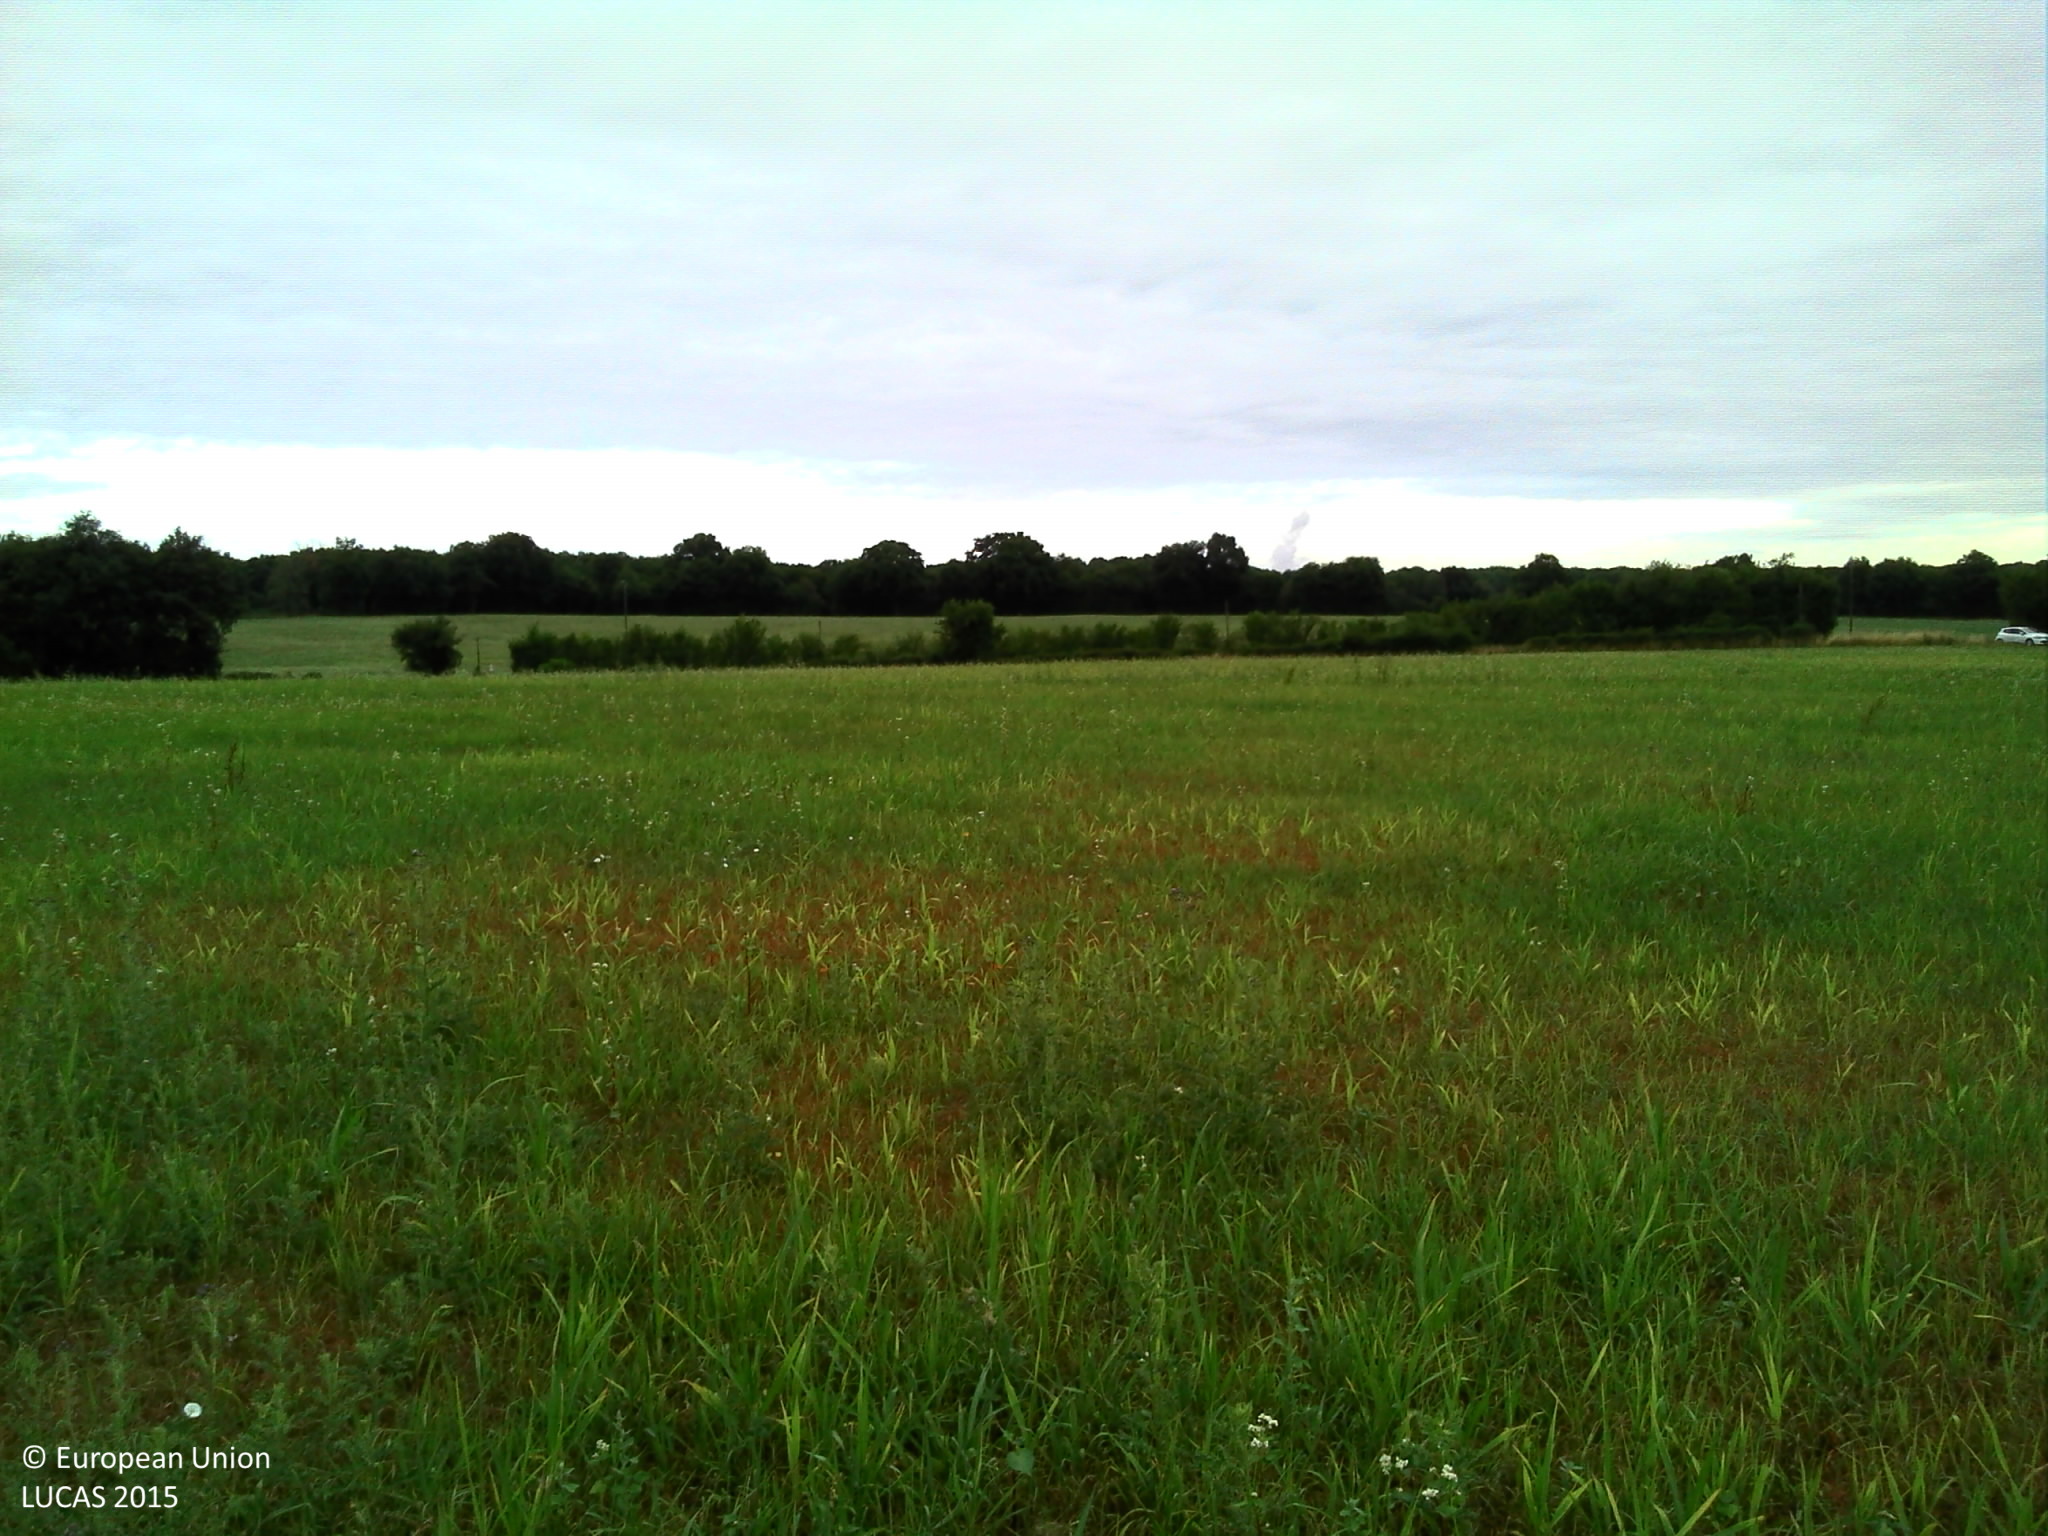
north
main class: Grassland
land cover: Grassland without tree/shrub cover
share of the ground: > 75 %
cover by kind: herbaceous plants 100 %
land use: Agriculture (excluding fallow land and kitchen gardens)
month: July
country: FR
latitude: 46.3569
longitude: 0.6400
